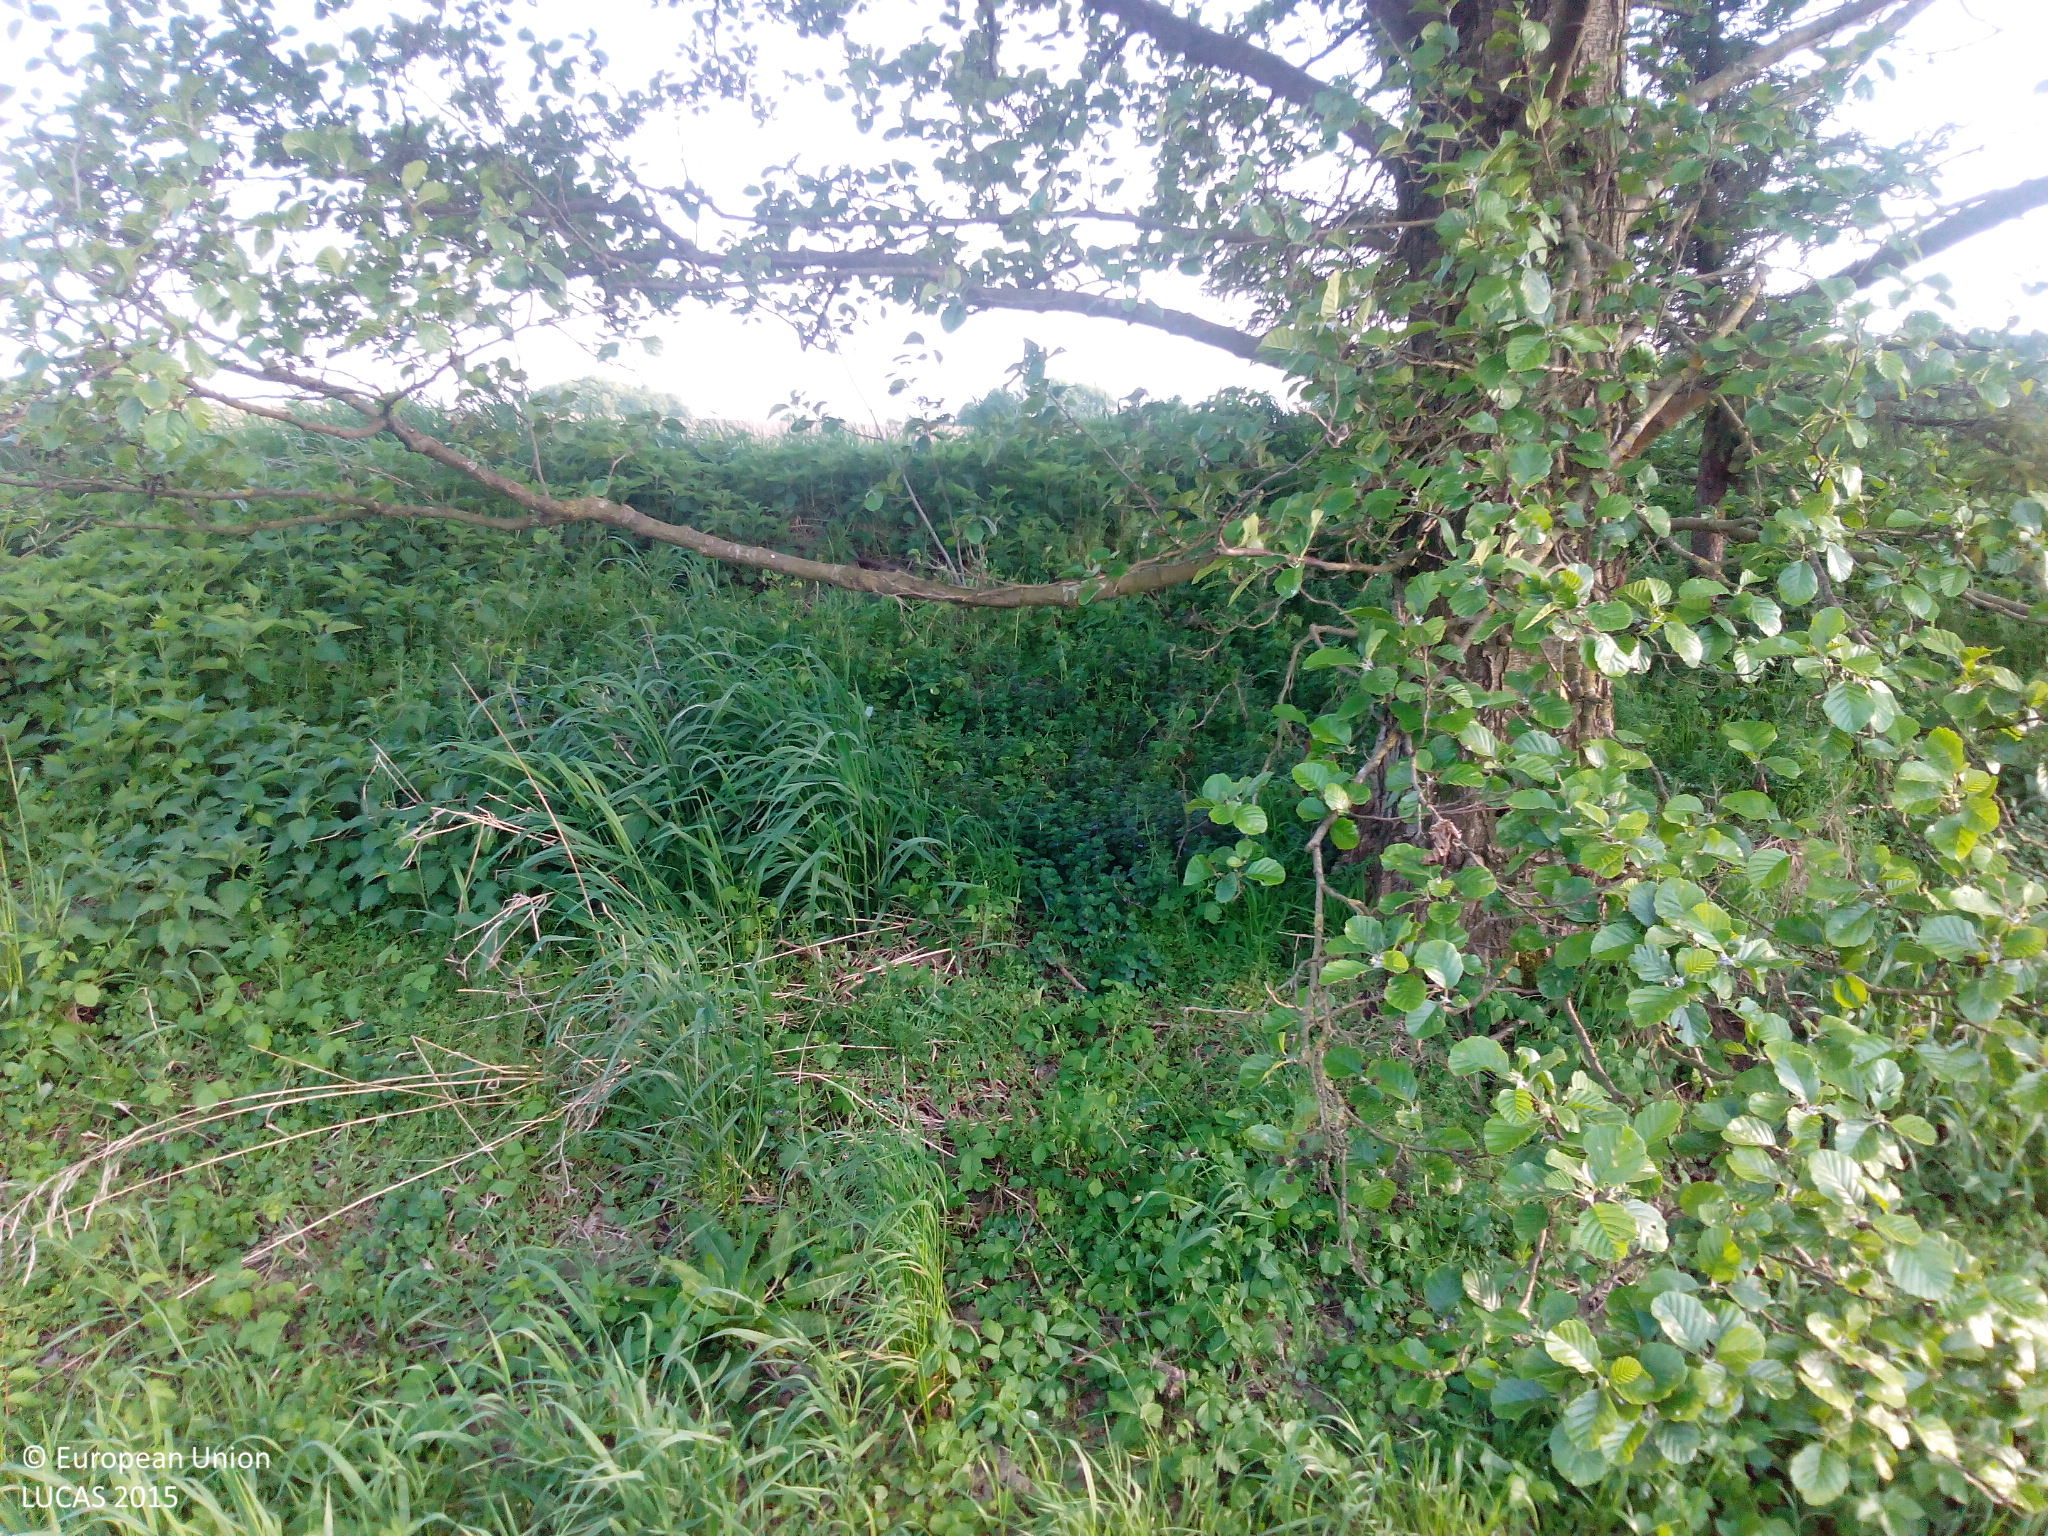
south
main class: Grassland
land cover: Grassland without tree/shrub cover
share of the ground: > 75 %
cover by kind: herbaceous plants 100 %
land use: Agriculture (excluding fallow land and kitchen gardens)
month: May
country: DE
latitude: 51.8389
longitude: 7.9830
